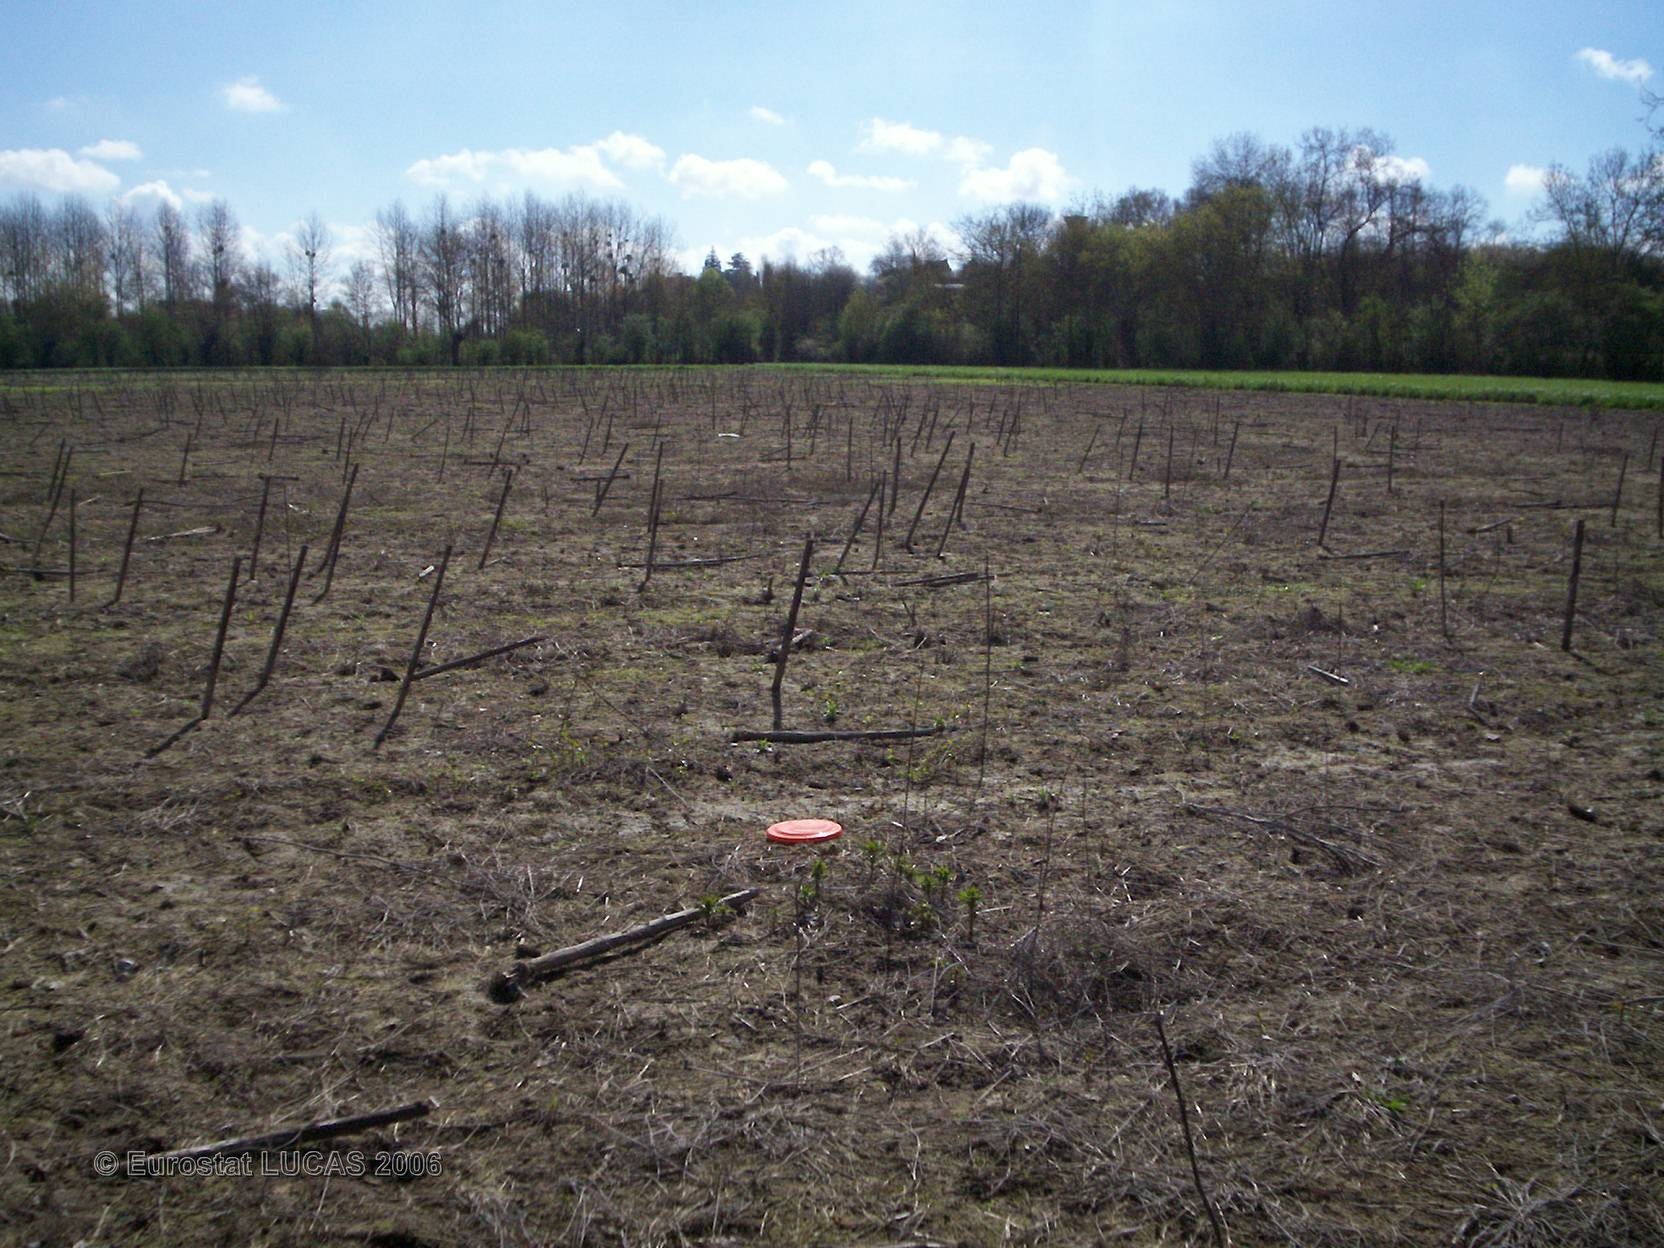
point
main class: Cropland
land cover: Maize
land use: Agriculture (excluding fallow land and kitchen gardens)
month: May
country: FR
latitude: 47.5634
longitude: -0.4376
